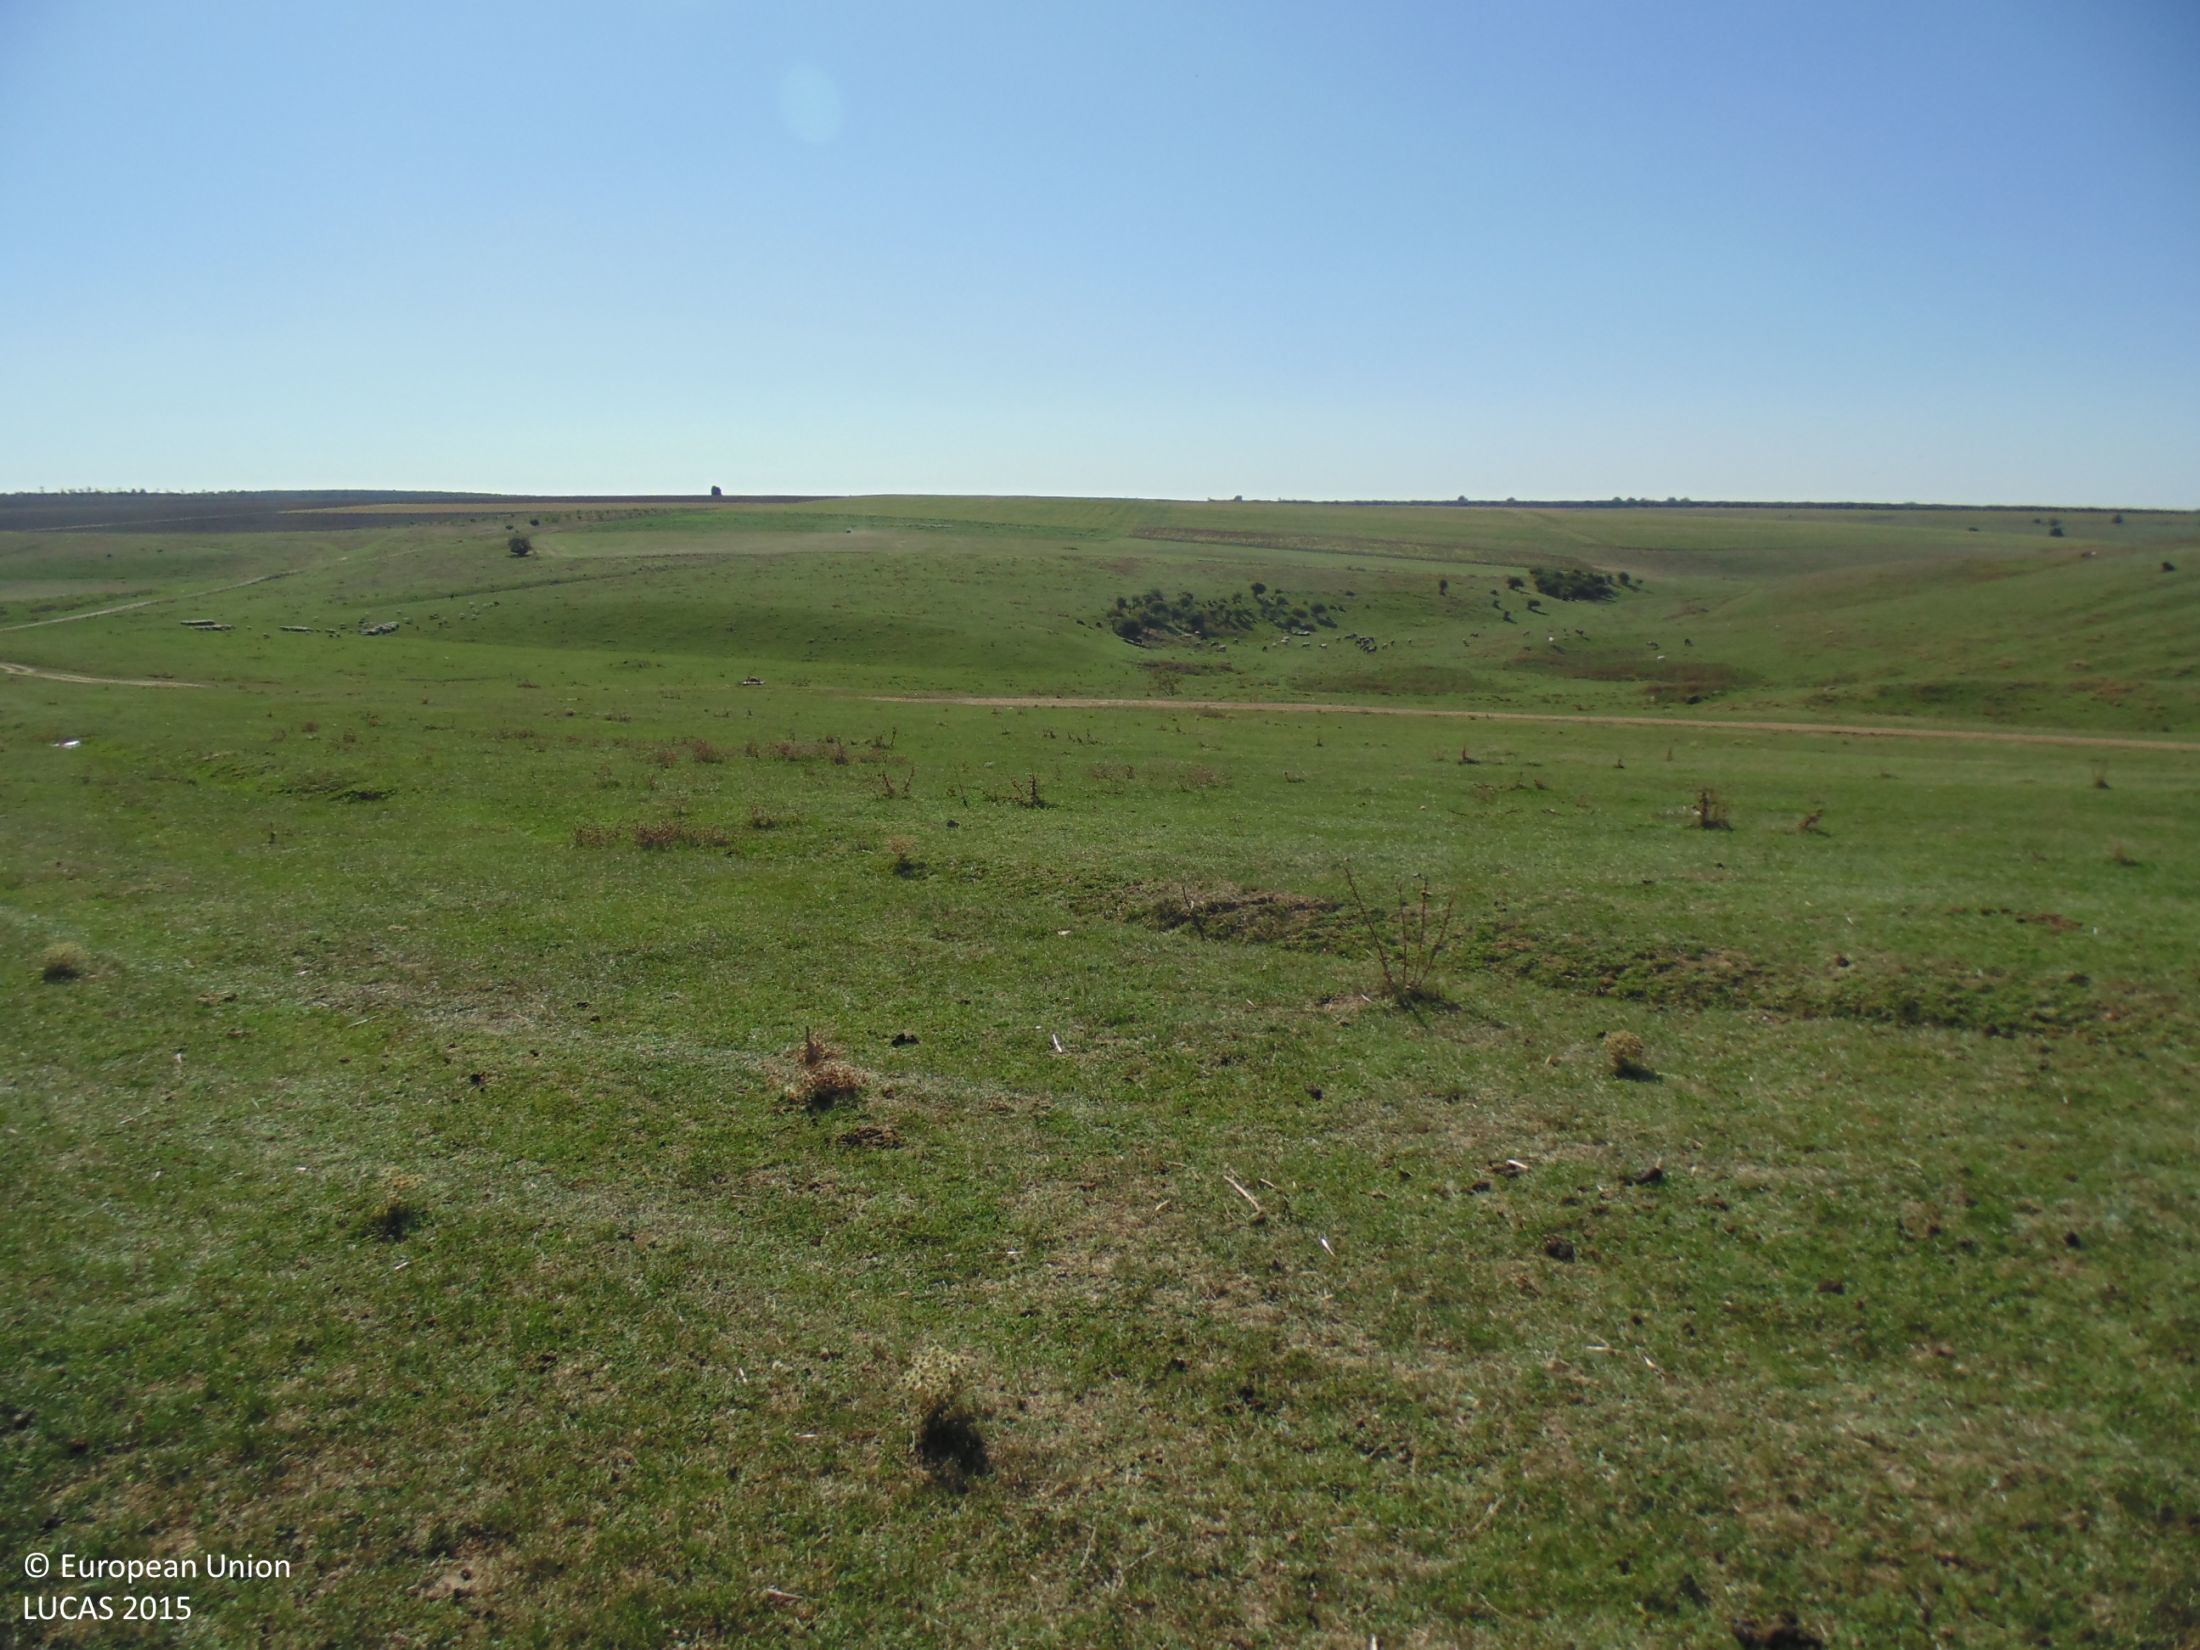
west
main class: Grassland
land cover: Grassland without tree/shrub cover
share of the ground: > 75 %
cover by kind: herbaceous plants 100 %
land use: Agriculture (excluding fallow land and kitchen gardens)
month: September
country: BG
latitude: 43.7251
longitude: 27.1176
